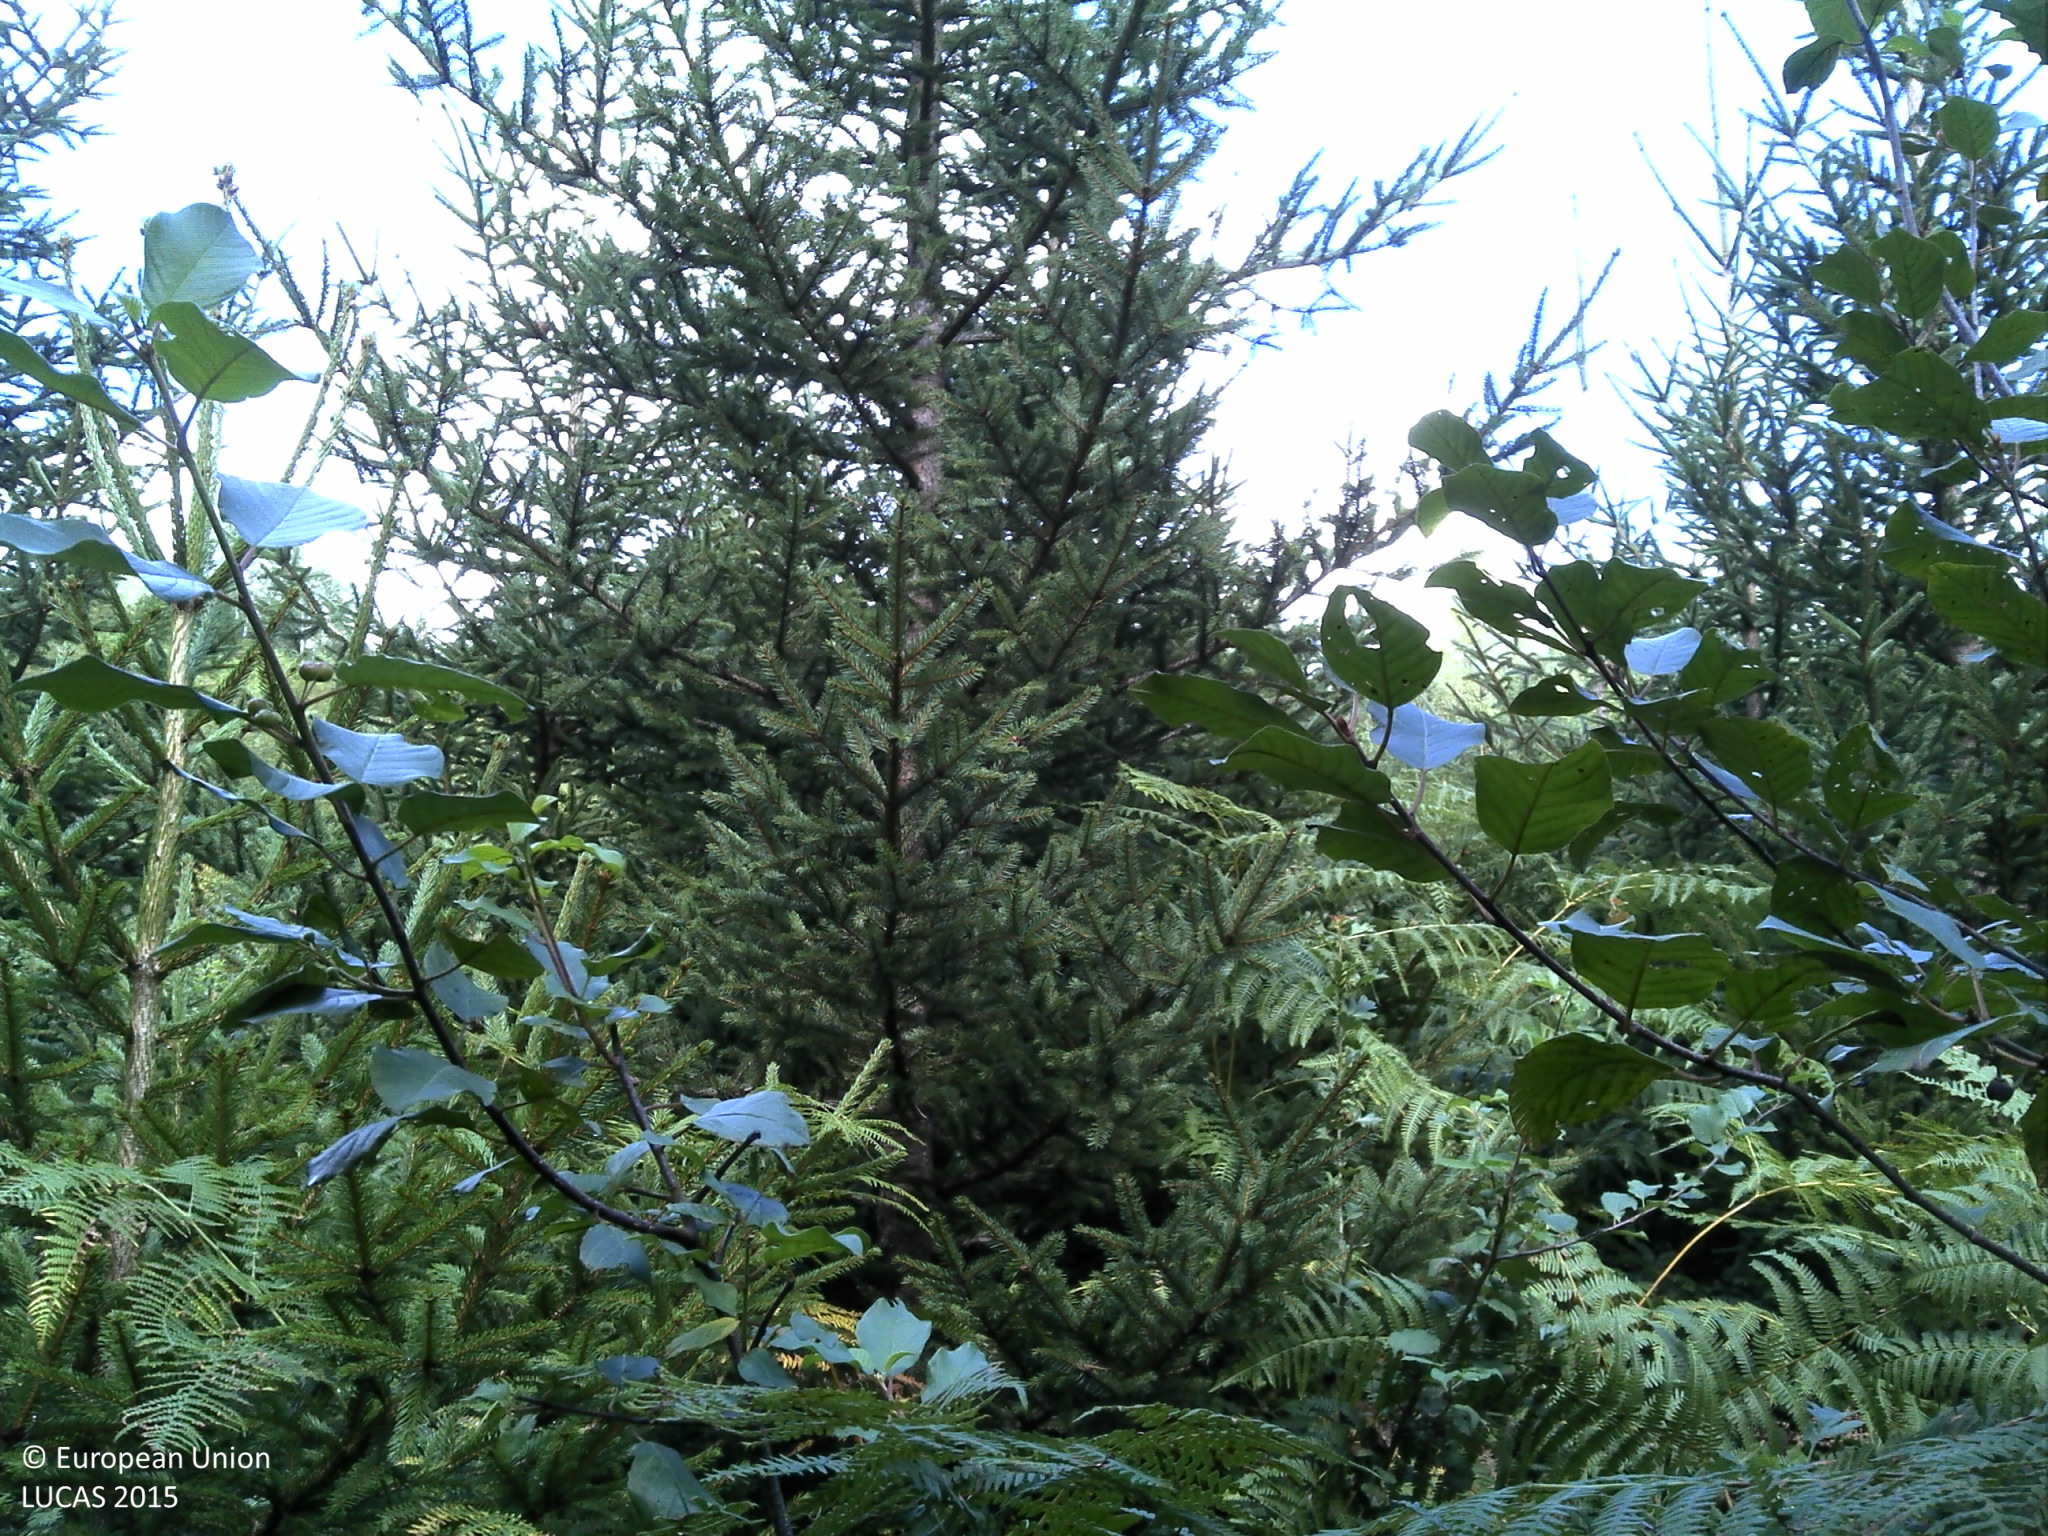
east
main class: Woodland
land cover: Spruce dominated coniferous woodland
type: coniferous forest of the mediterranean region
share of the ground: > 75 %
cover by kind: coniferous forest trees 100 %
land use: Forestry
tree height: > 5 m
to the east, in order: Spruce dominated coniferous woodland; Tracks; Spruce dominated coniferous woodland
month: September
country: HR
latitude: 45.2984
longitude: 15.3131
